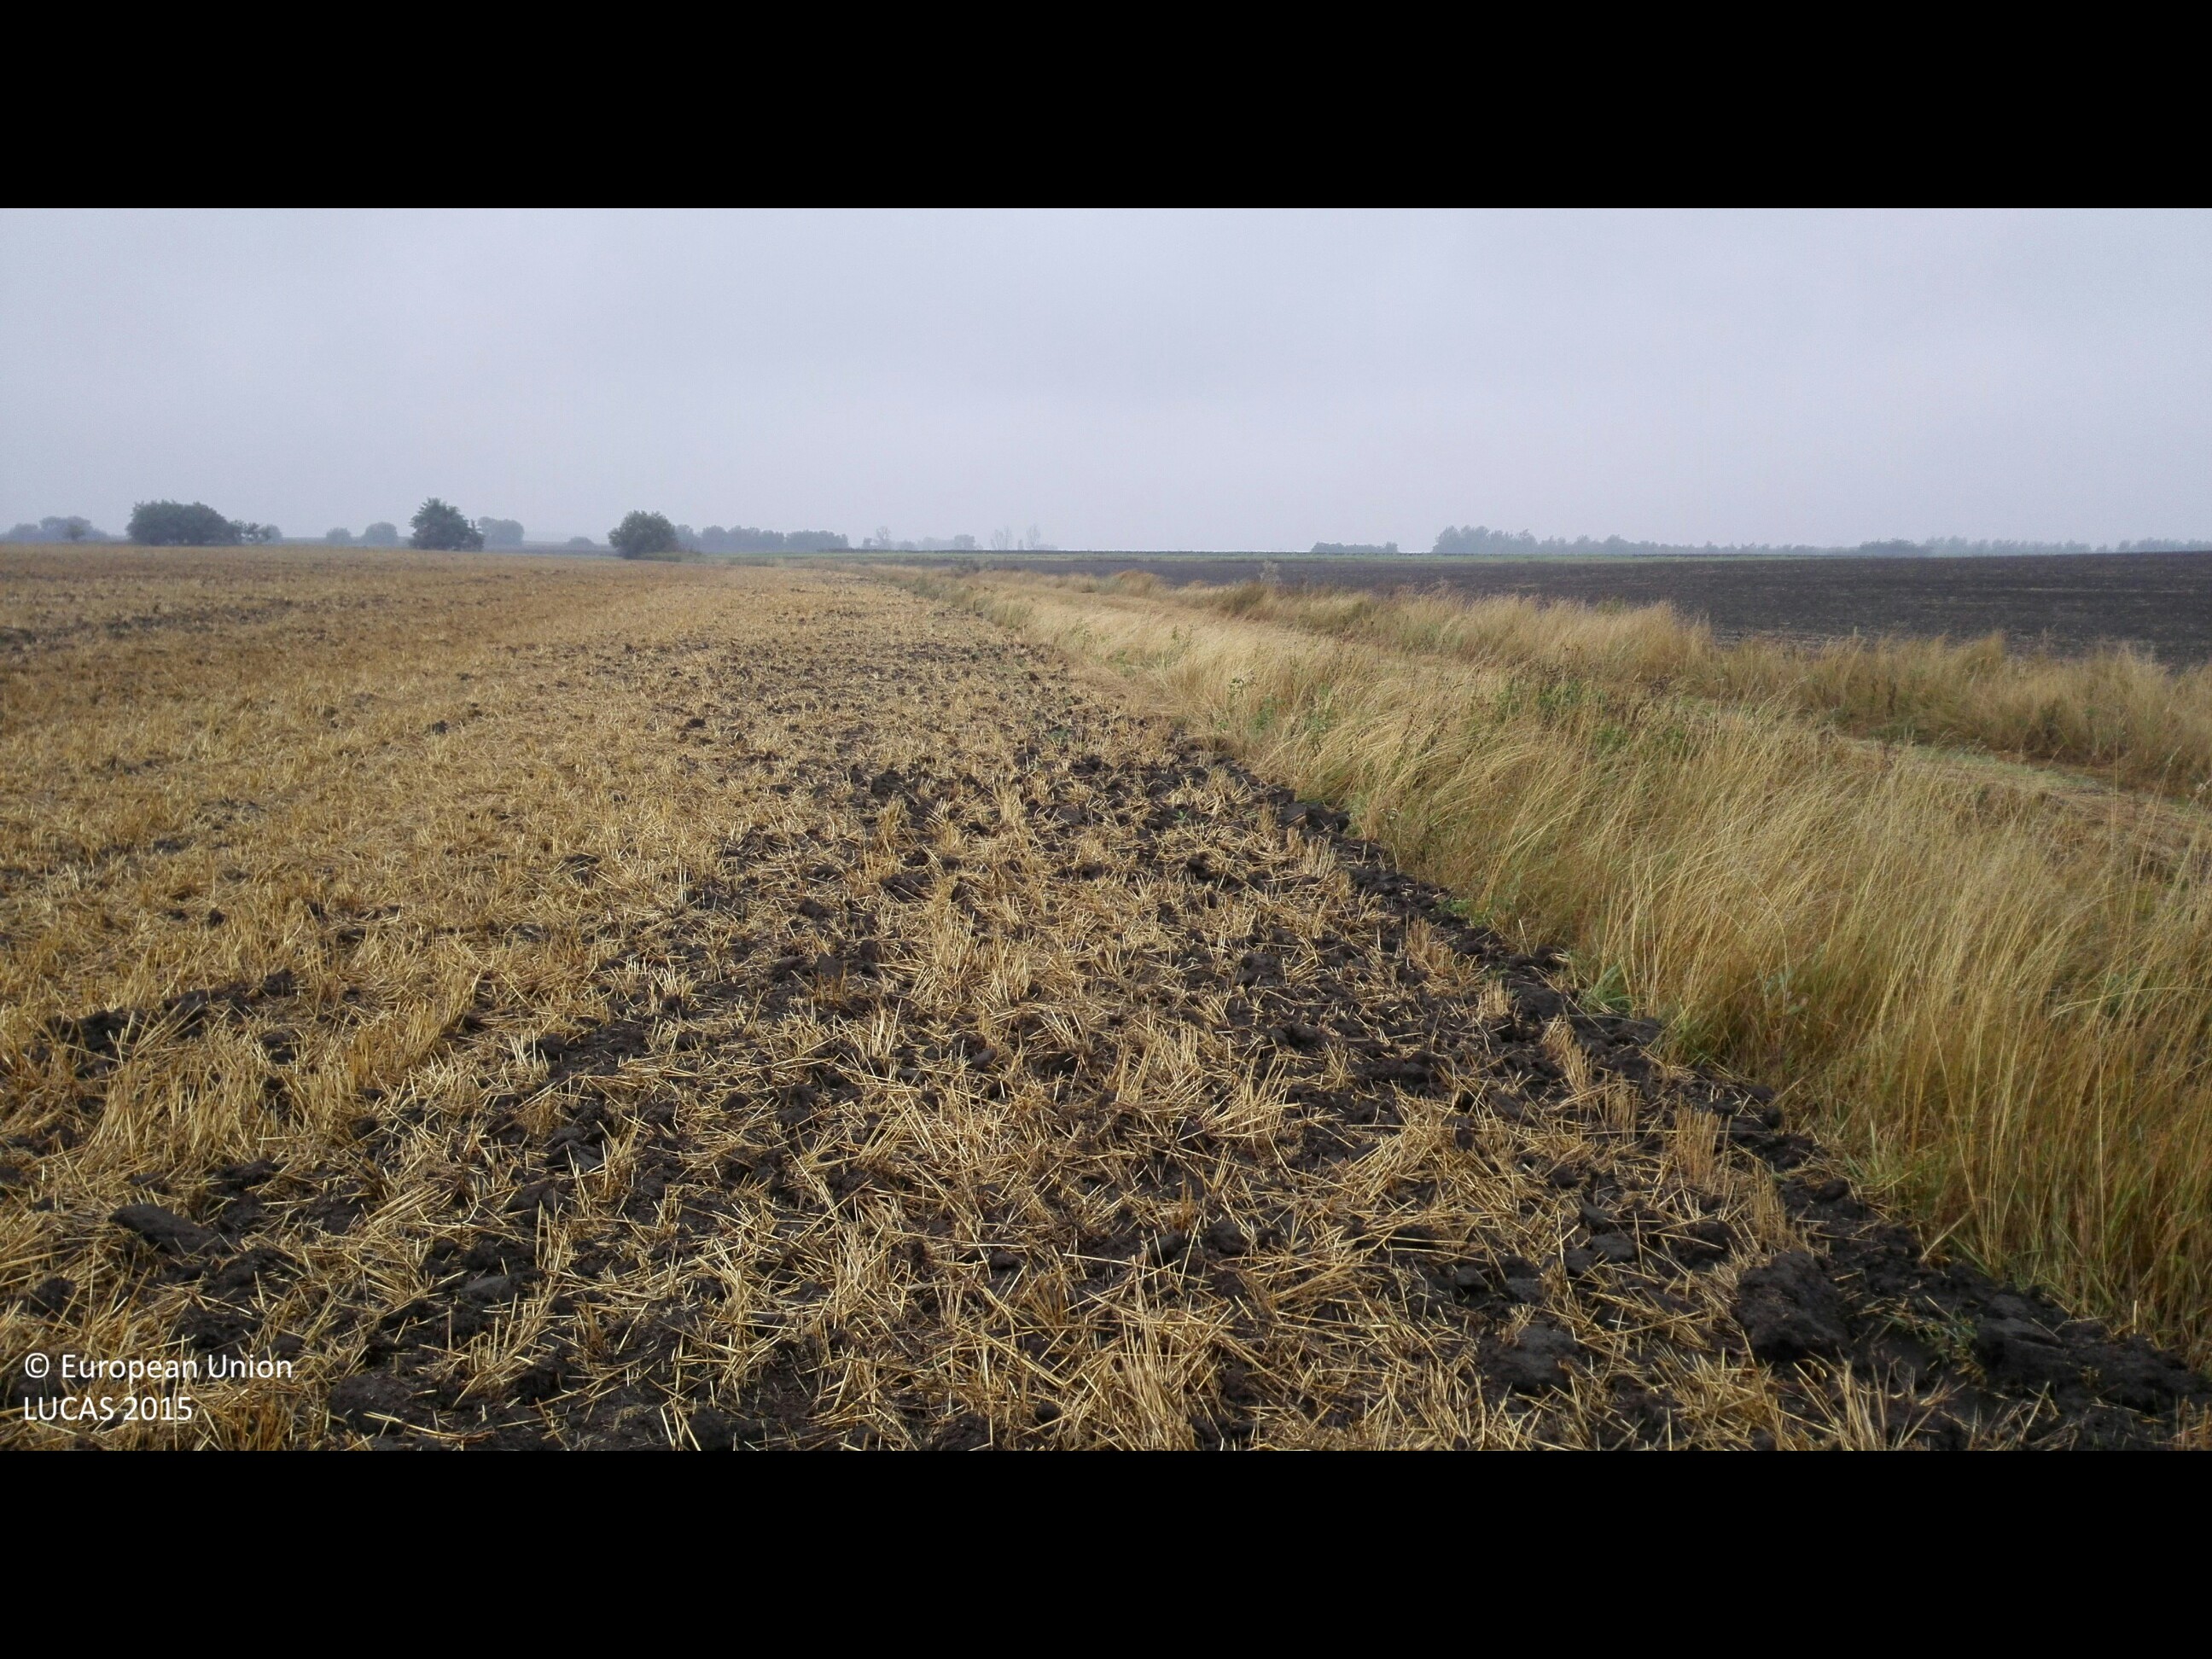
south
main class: Cropland
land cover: Common wheat
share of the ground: 10 - 25 %
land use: Agriculture (excluding fallow land and kitchen gardens)
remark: Harvested field
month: August
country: HU
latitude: 47.2102
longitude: 21.7557
